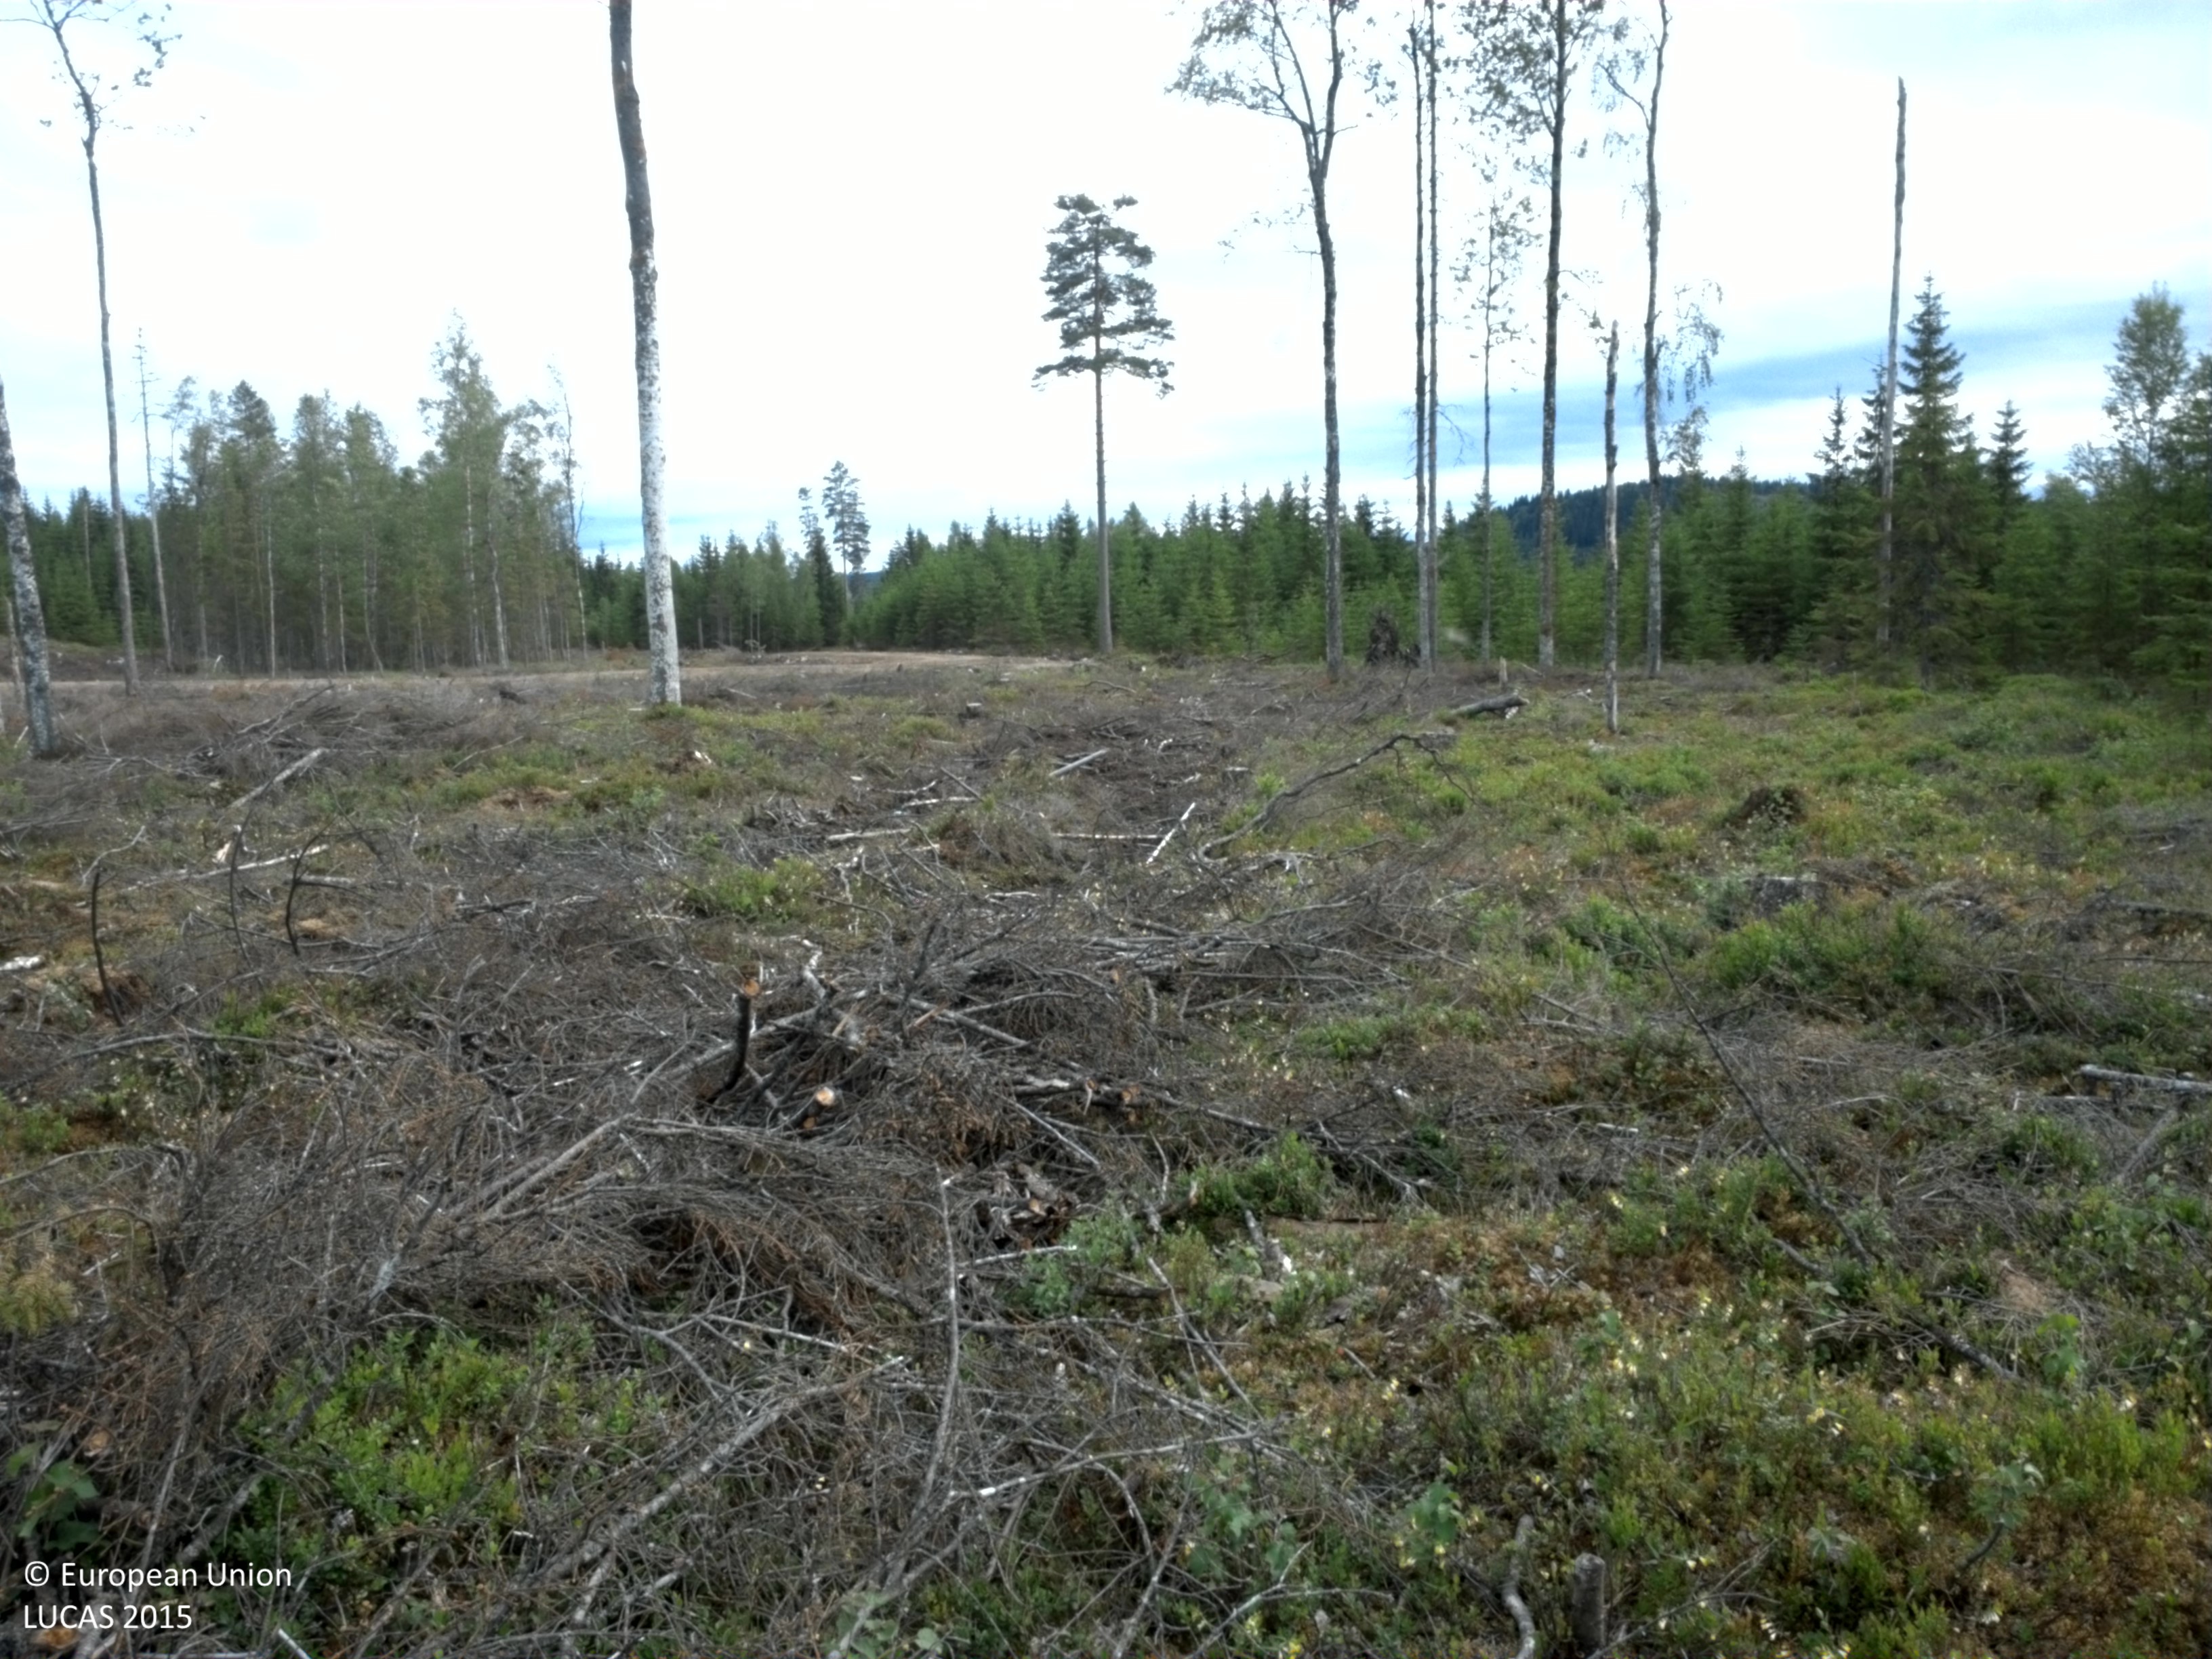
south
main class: Woodland
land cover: Broadleaved woodland
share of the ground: 10 - 25 %
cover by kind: shrubs 55 %, herbaceous plants 20 %, broadleaved forest trees 15 %, unconsolidated bare surface 10 %
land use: Forestry
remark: Clear cut
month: July
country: SE
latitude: 59.7508
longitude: 14.4217
